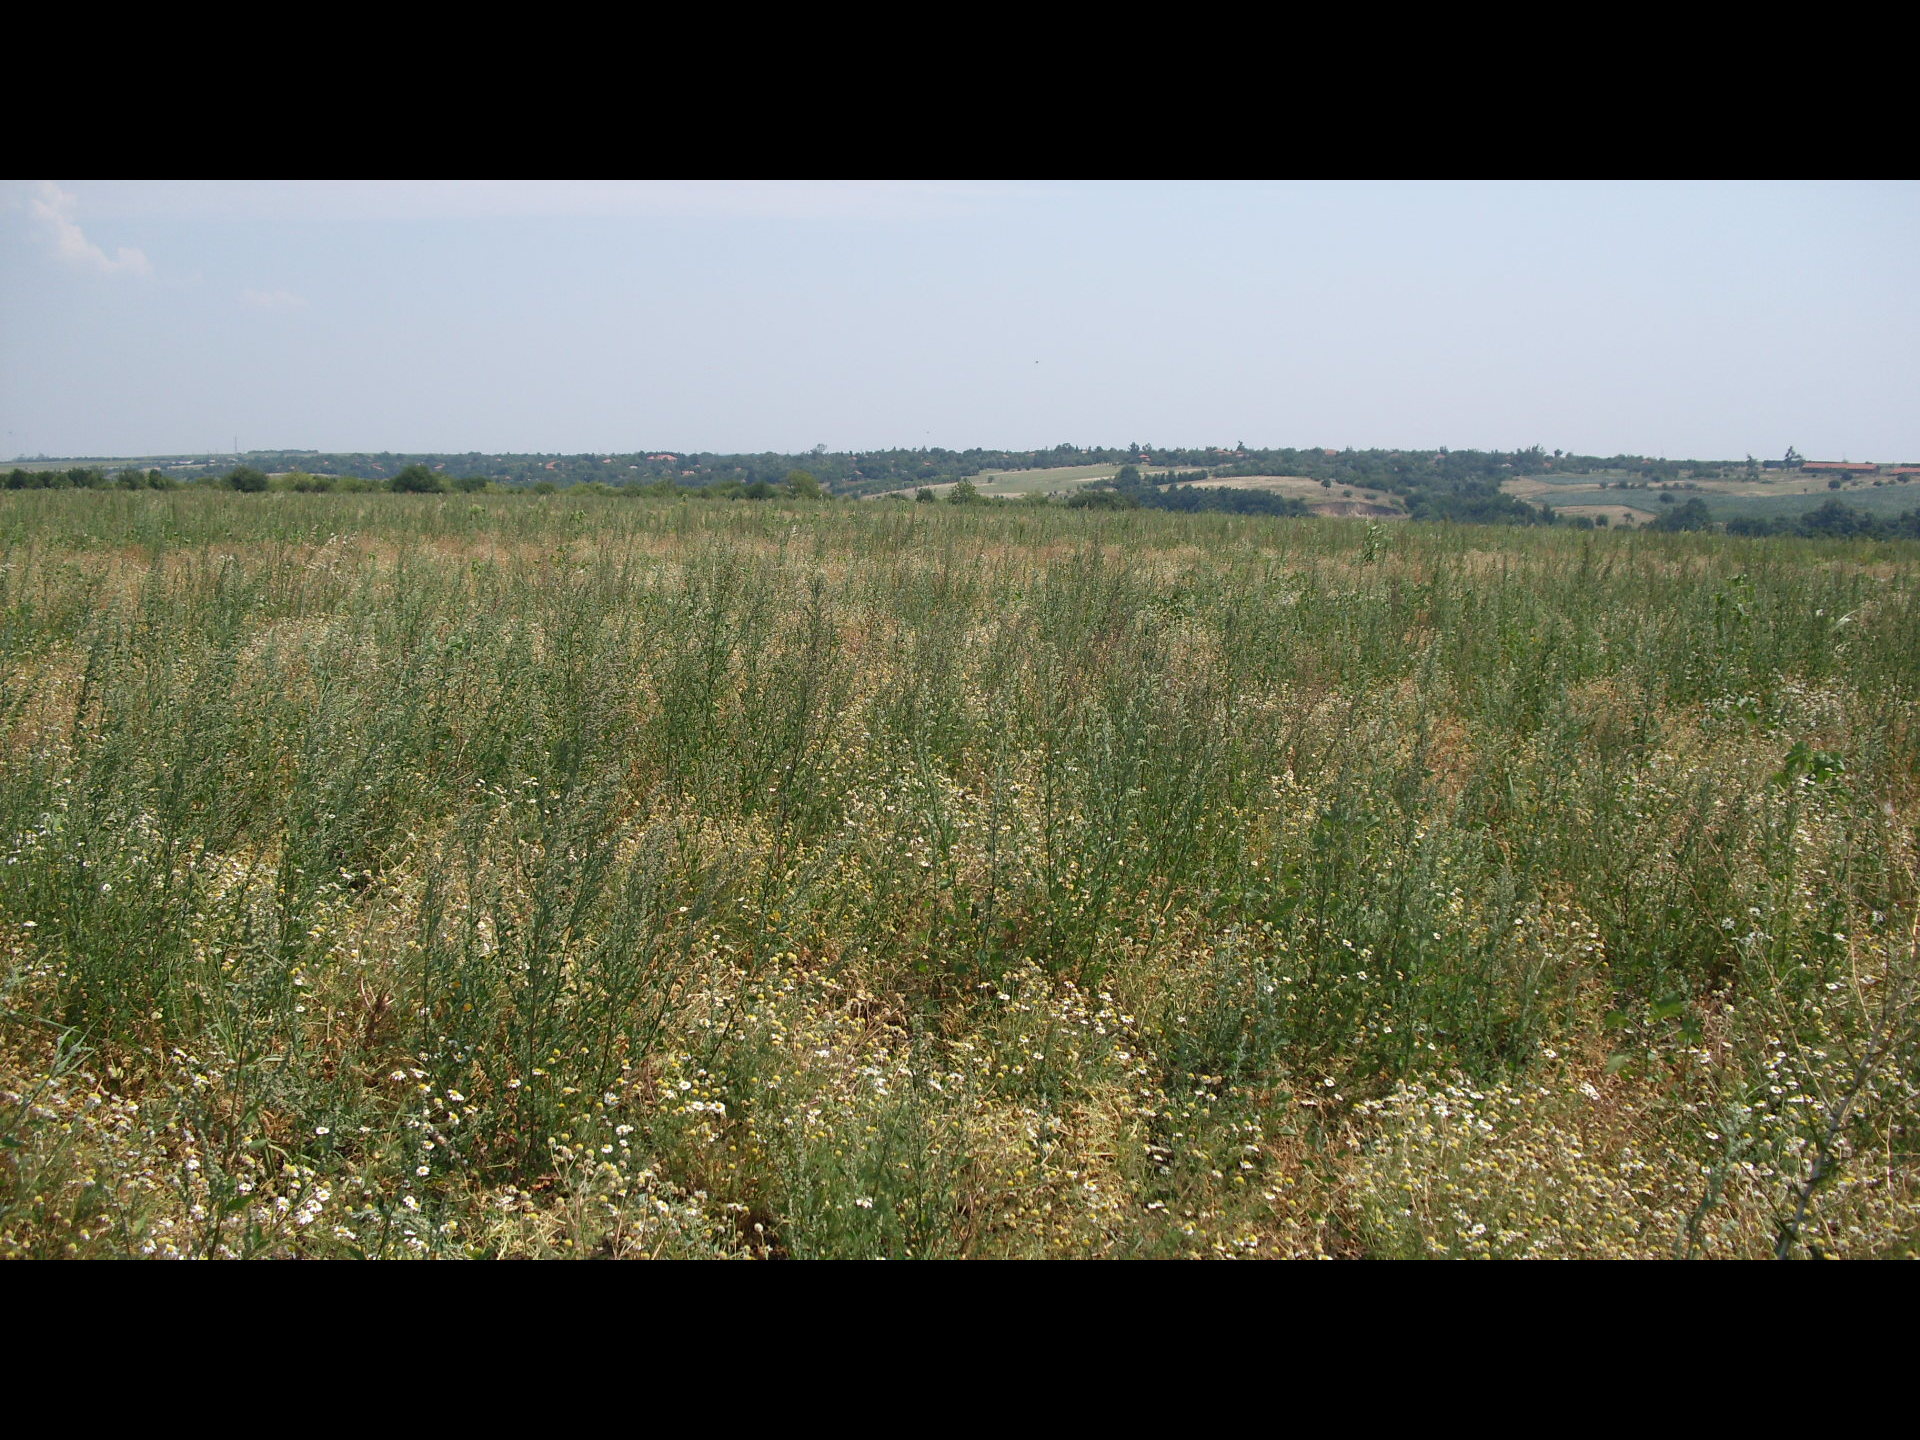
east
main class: Grassland
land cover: Spontaneously vegetated surfaces
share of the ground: > 75 %
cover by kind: herbaceous plants 100 %
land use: Fallow land
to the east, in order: Spontaneously vegetated surfaces
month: July
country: BG
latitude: 43.8158
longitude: 22.6036
